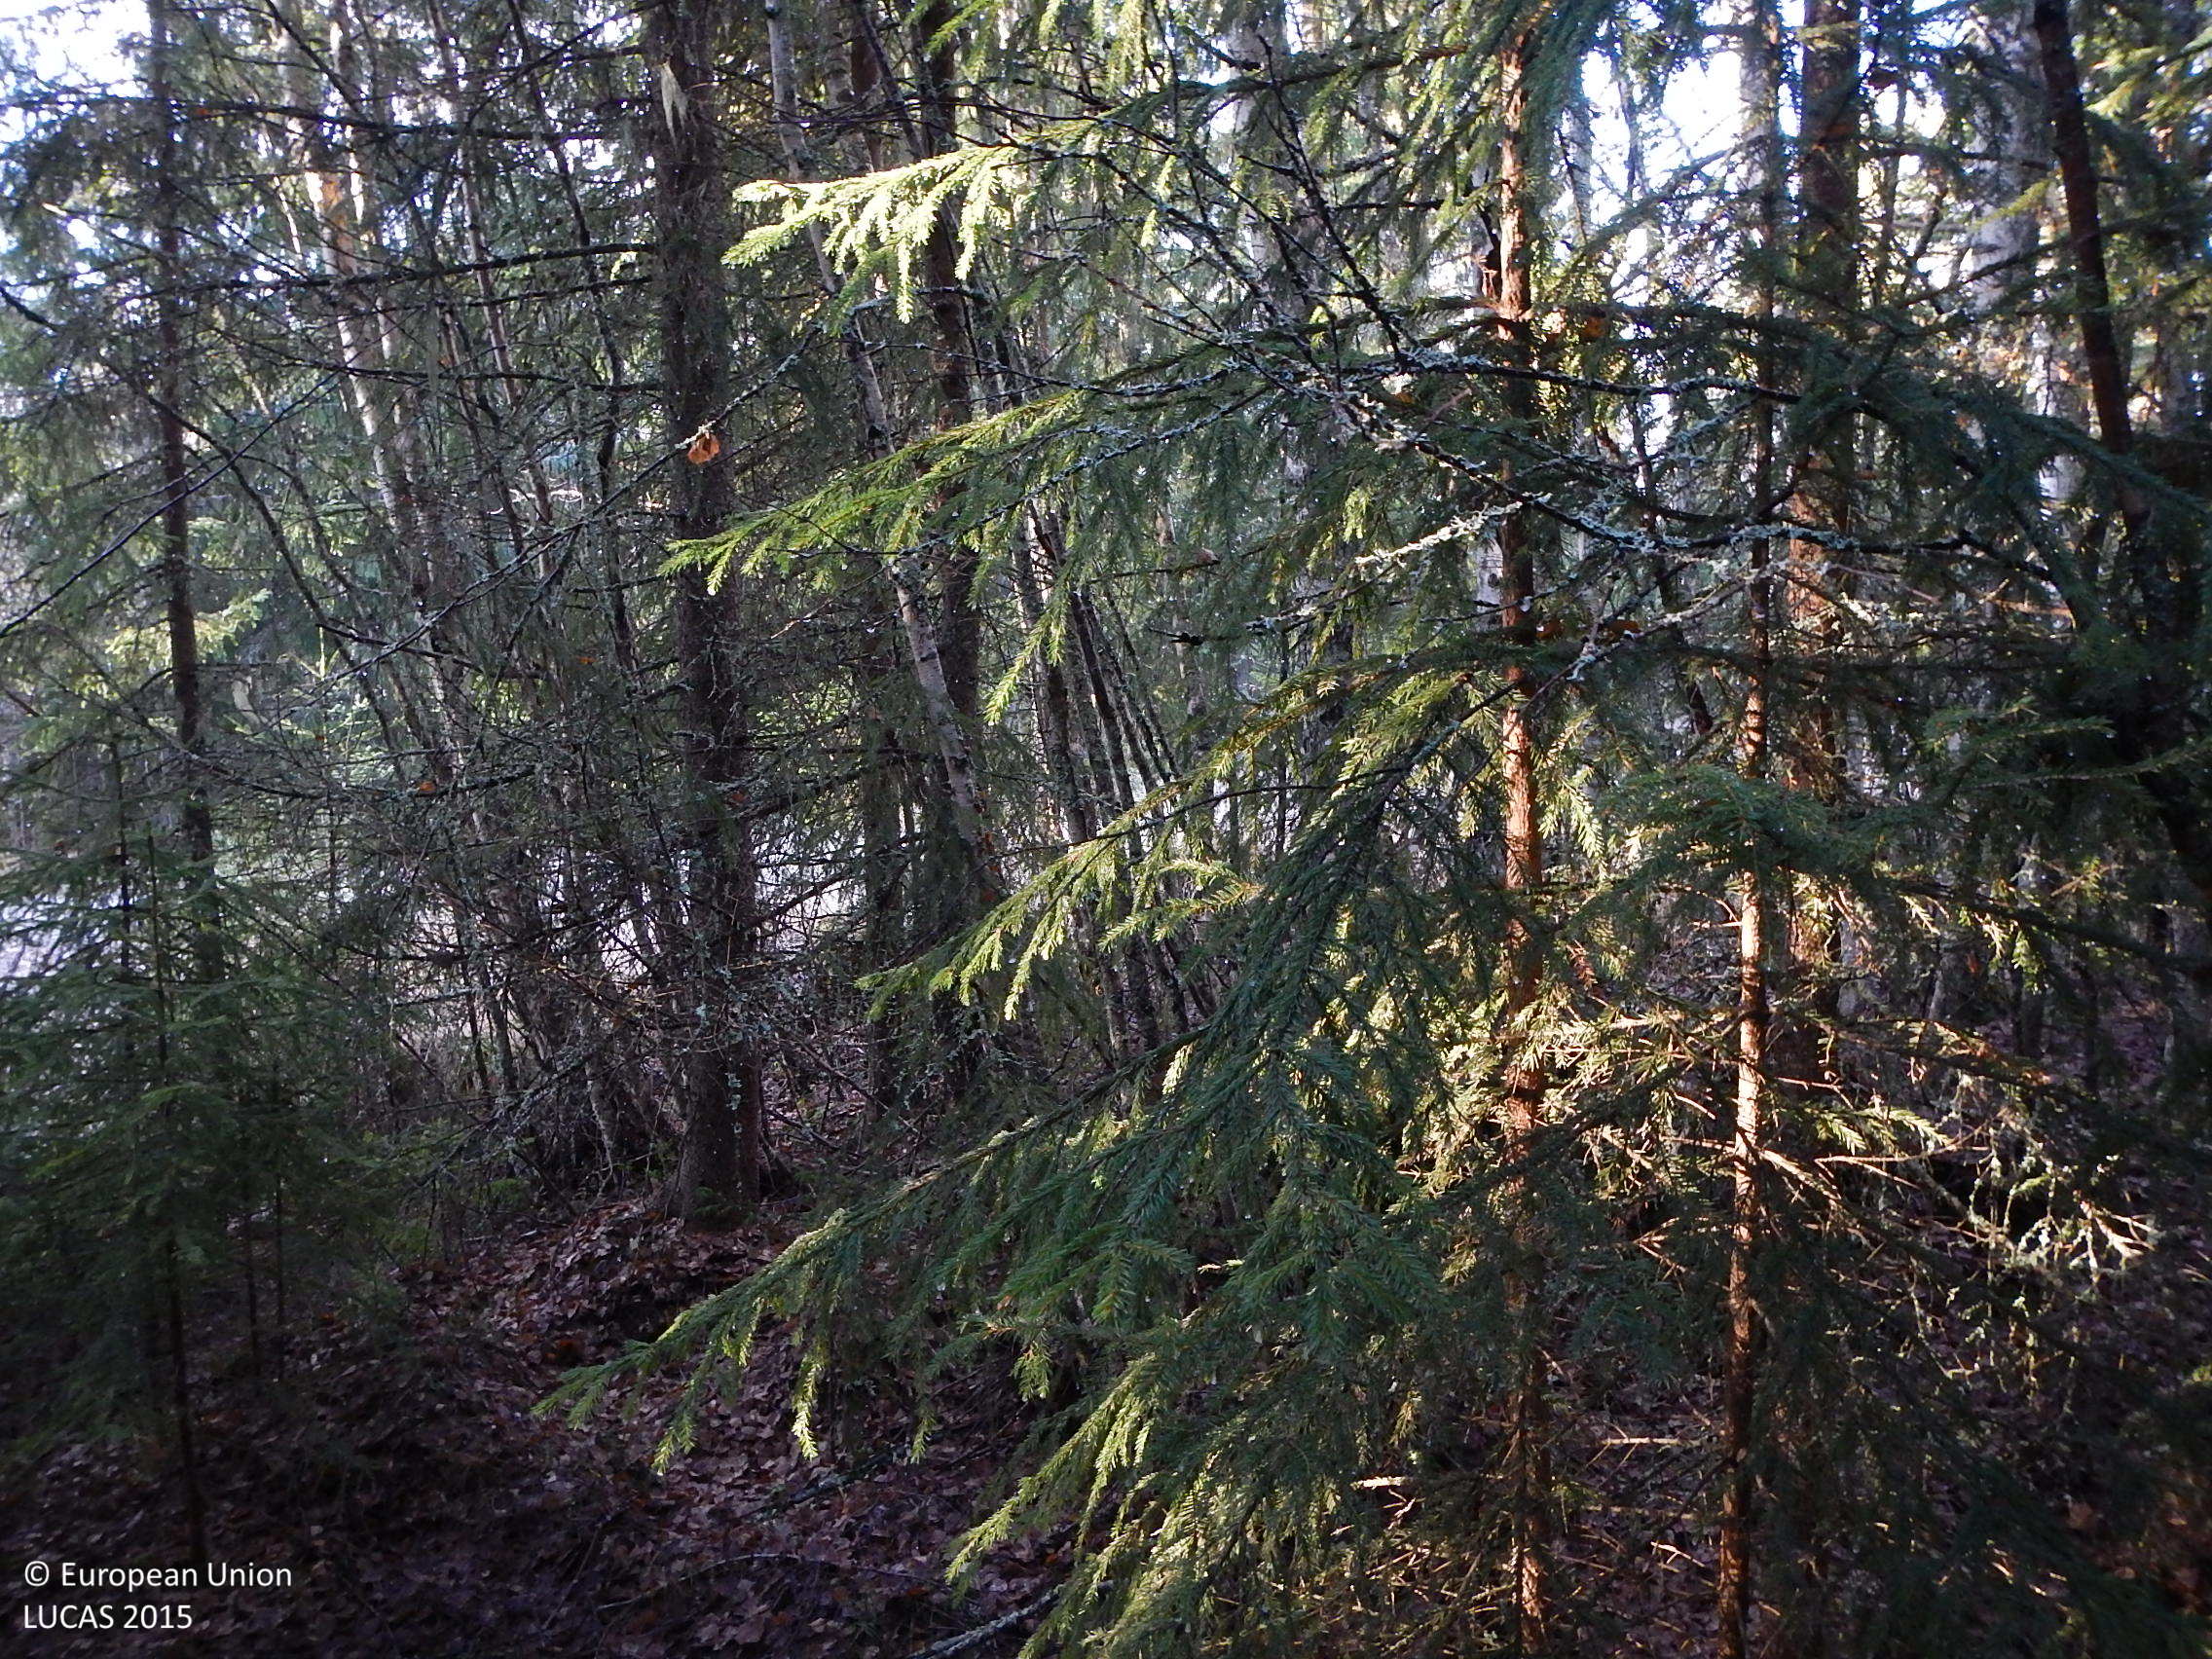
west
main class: Woodland
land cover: Spruce dominated mixed woodland
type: boreal forest
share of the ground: 50 - 75 %
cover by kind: coniferous forest trees 40 %, broadleaved forest trees 30 %, shrubs 15 %, unconsolidated bare surface 10 %, lichens and mosses 5 %
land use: Forestry
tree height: > 5 m
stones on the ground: < 10 %
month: November
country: SE
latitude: 61.5680
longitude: 16.0649
